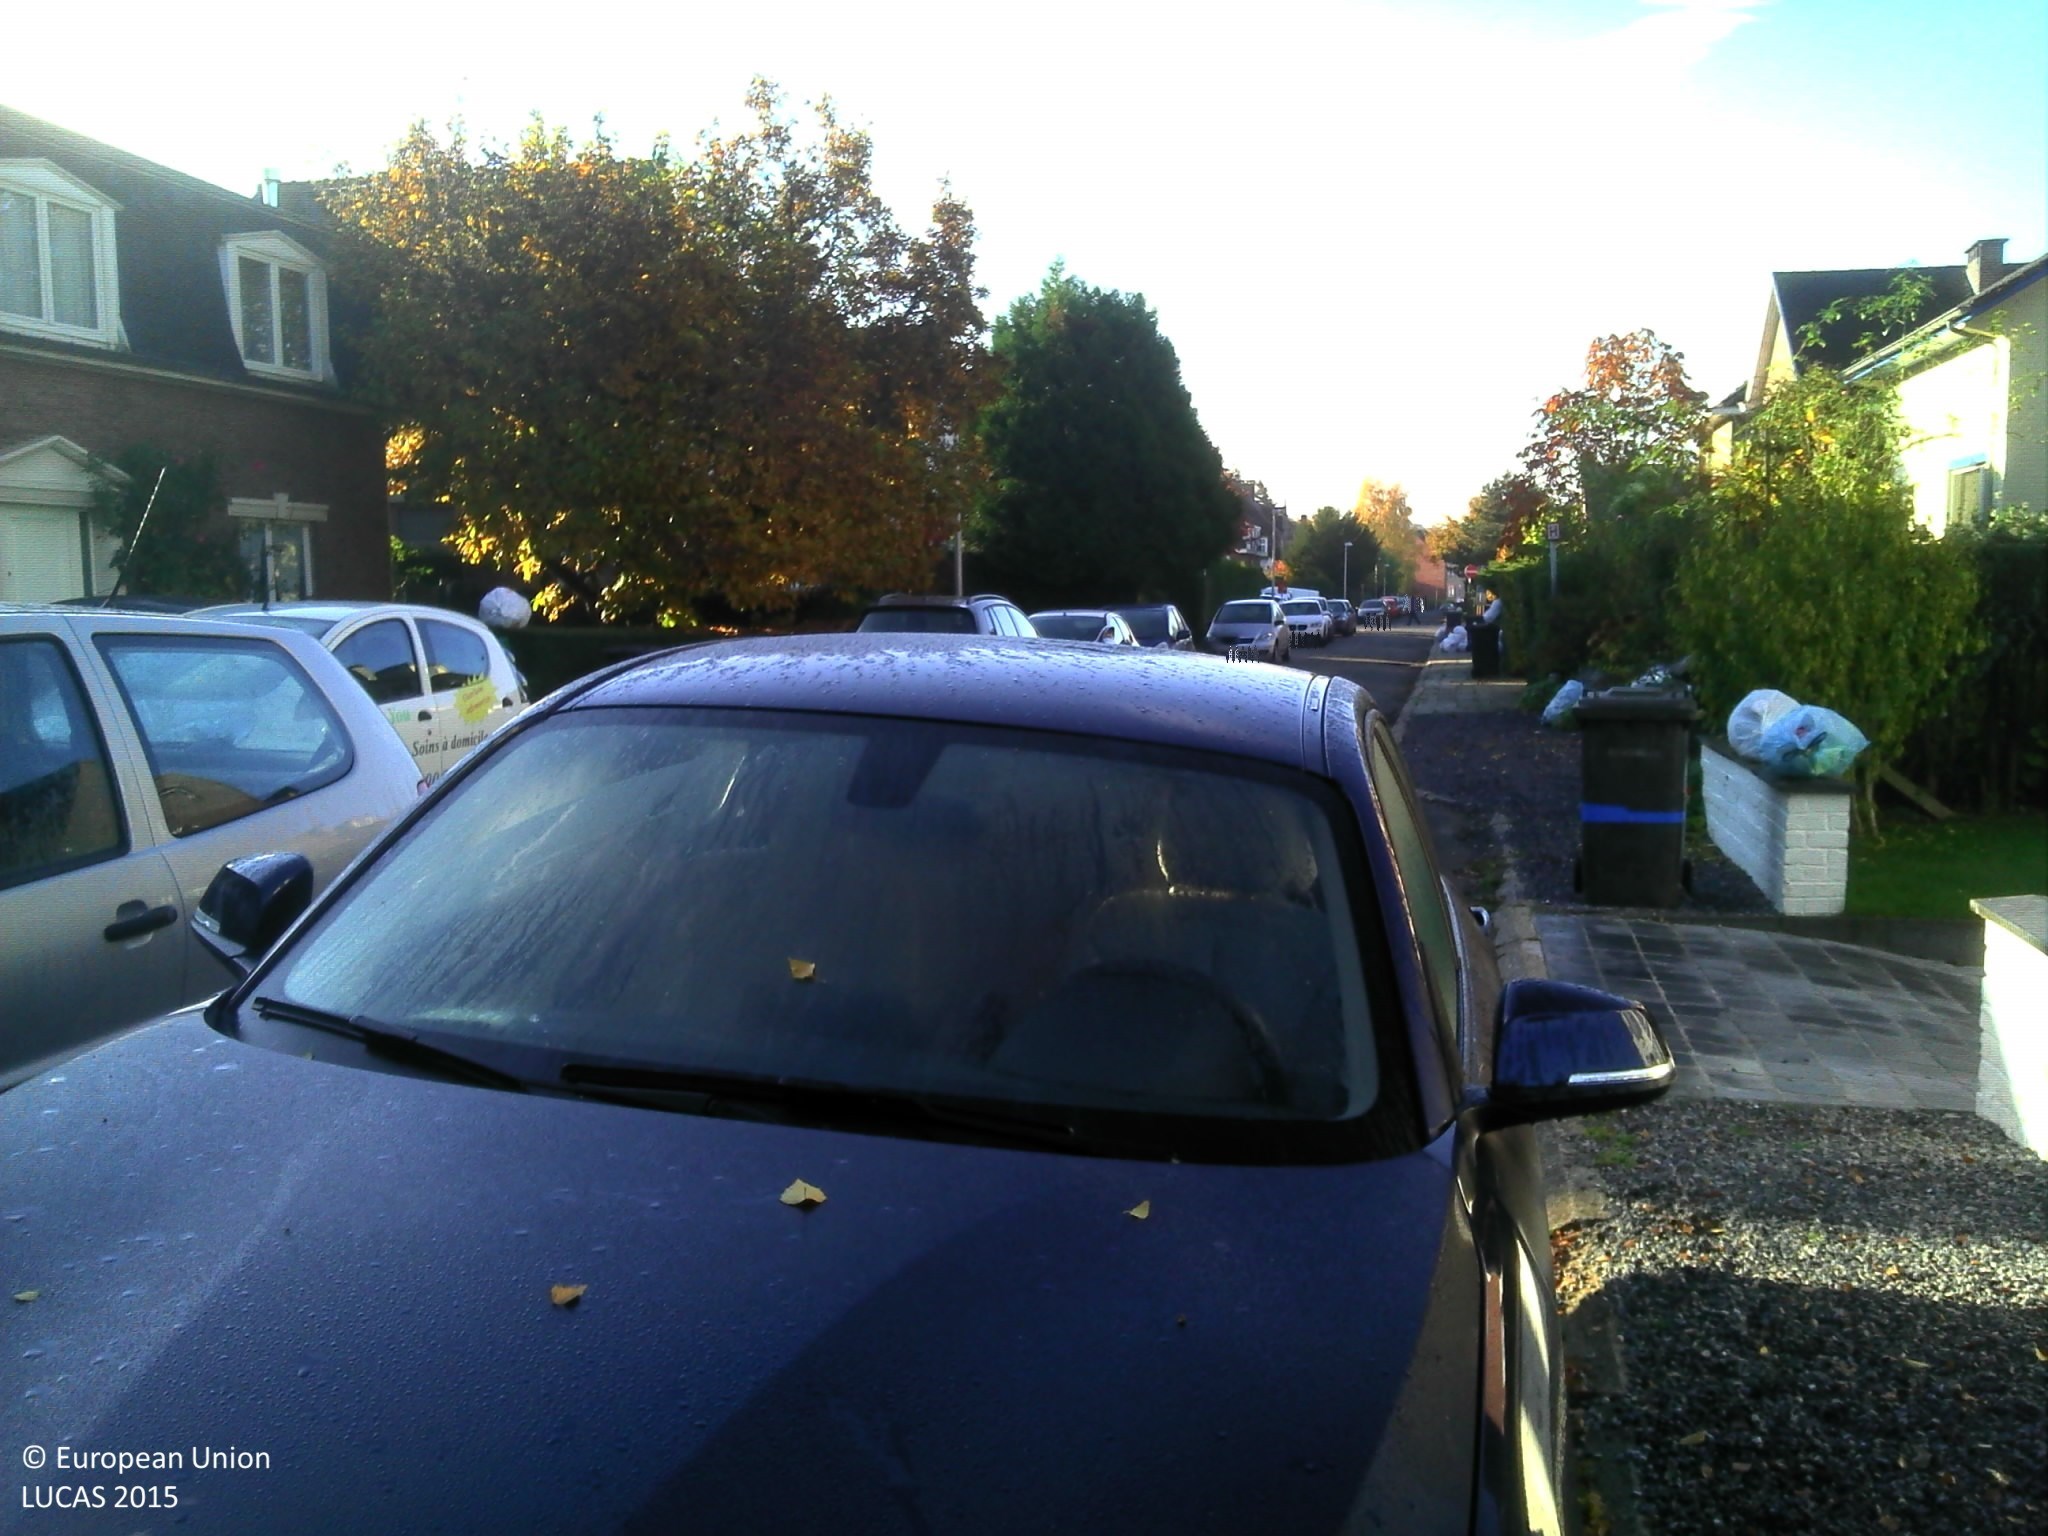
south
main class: Grassland
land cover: Grassland with sparse tree/shrub cover
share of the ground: > 75 %
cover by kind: herbaceous plants 85 %, shrubs 10 %, coniferous forest trees 5 %
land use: Residential
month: October
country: BE
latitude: 50.8432
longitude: 4.4712
